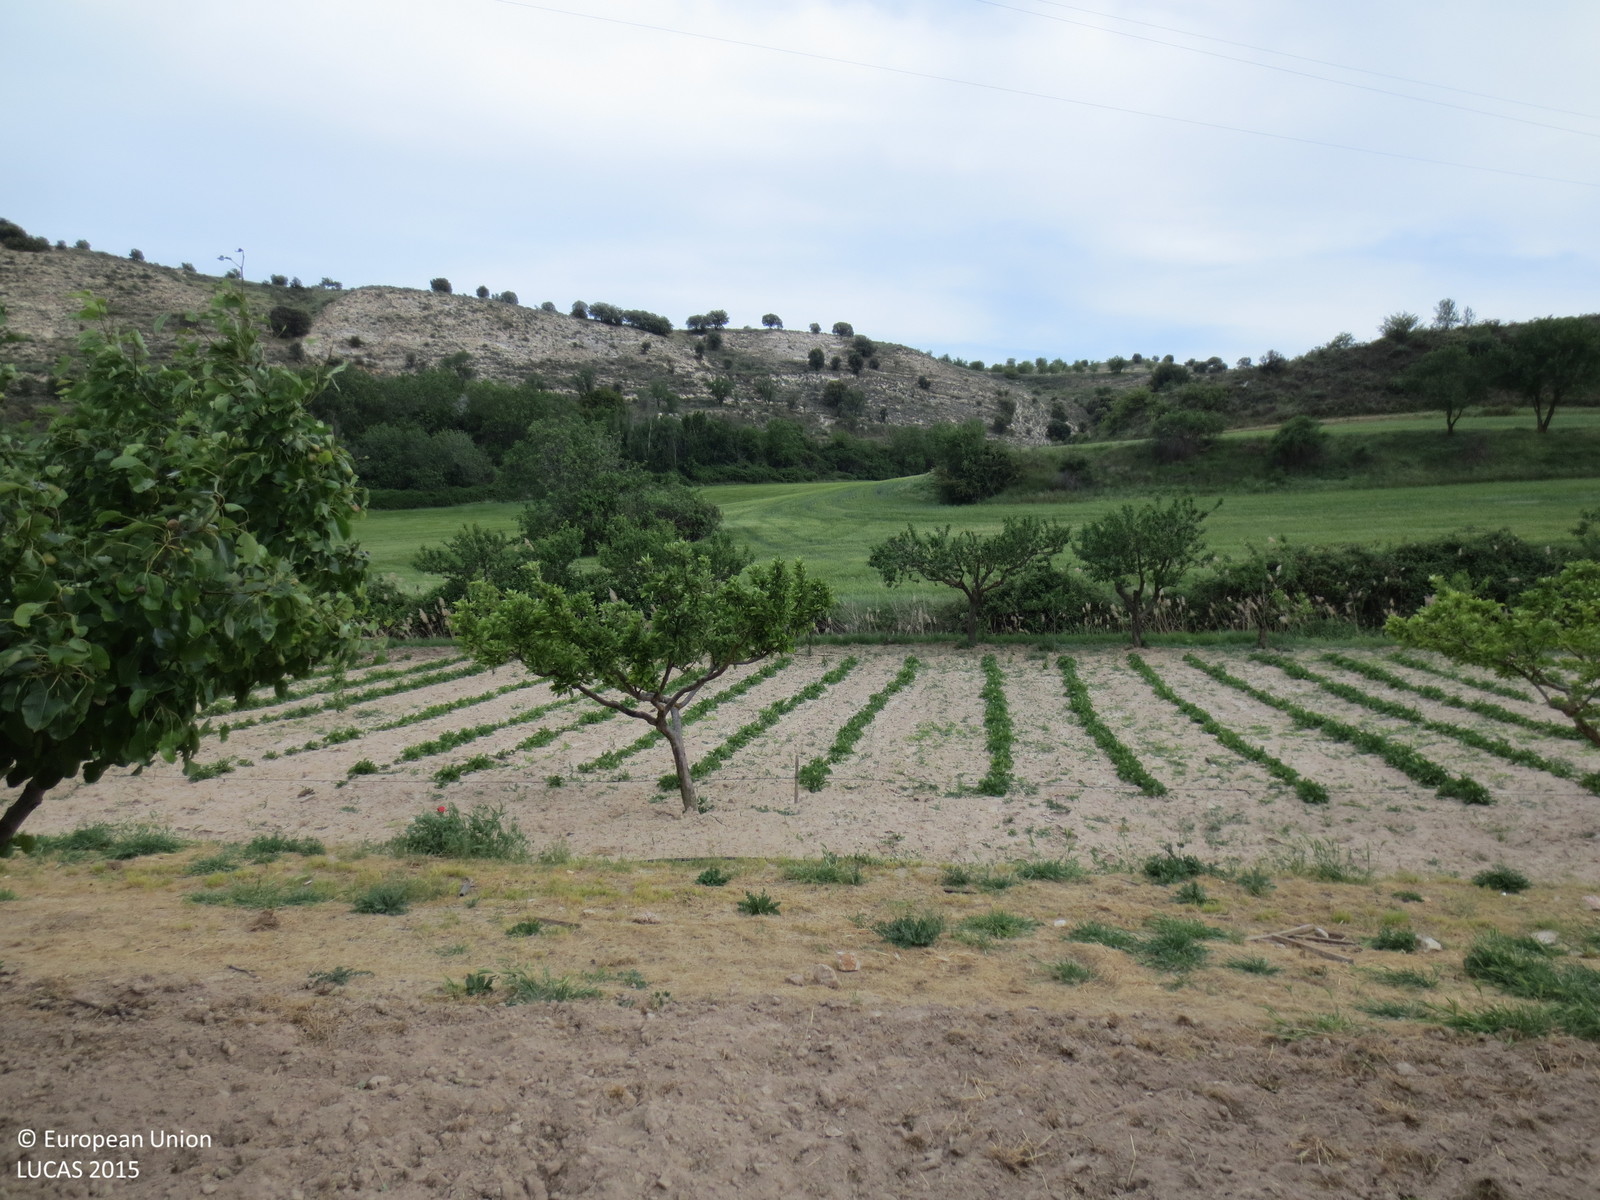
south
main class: Cropland
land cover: Nuts trees
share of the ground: 25 - 50 %
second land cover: Other fruit trees and berries
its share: 25 - 50 %
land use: Agriculture (excluding fallow land and kitchen gardens)
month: May
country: ES
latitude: 40.3761
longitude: -2.5197
